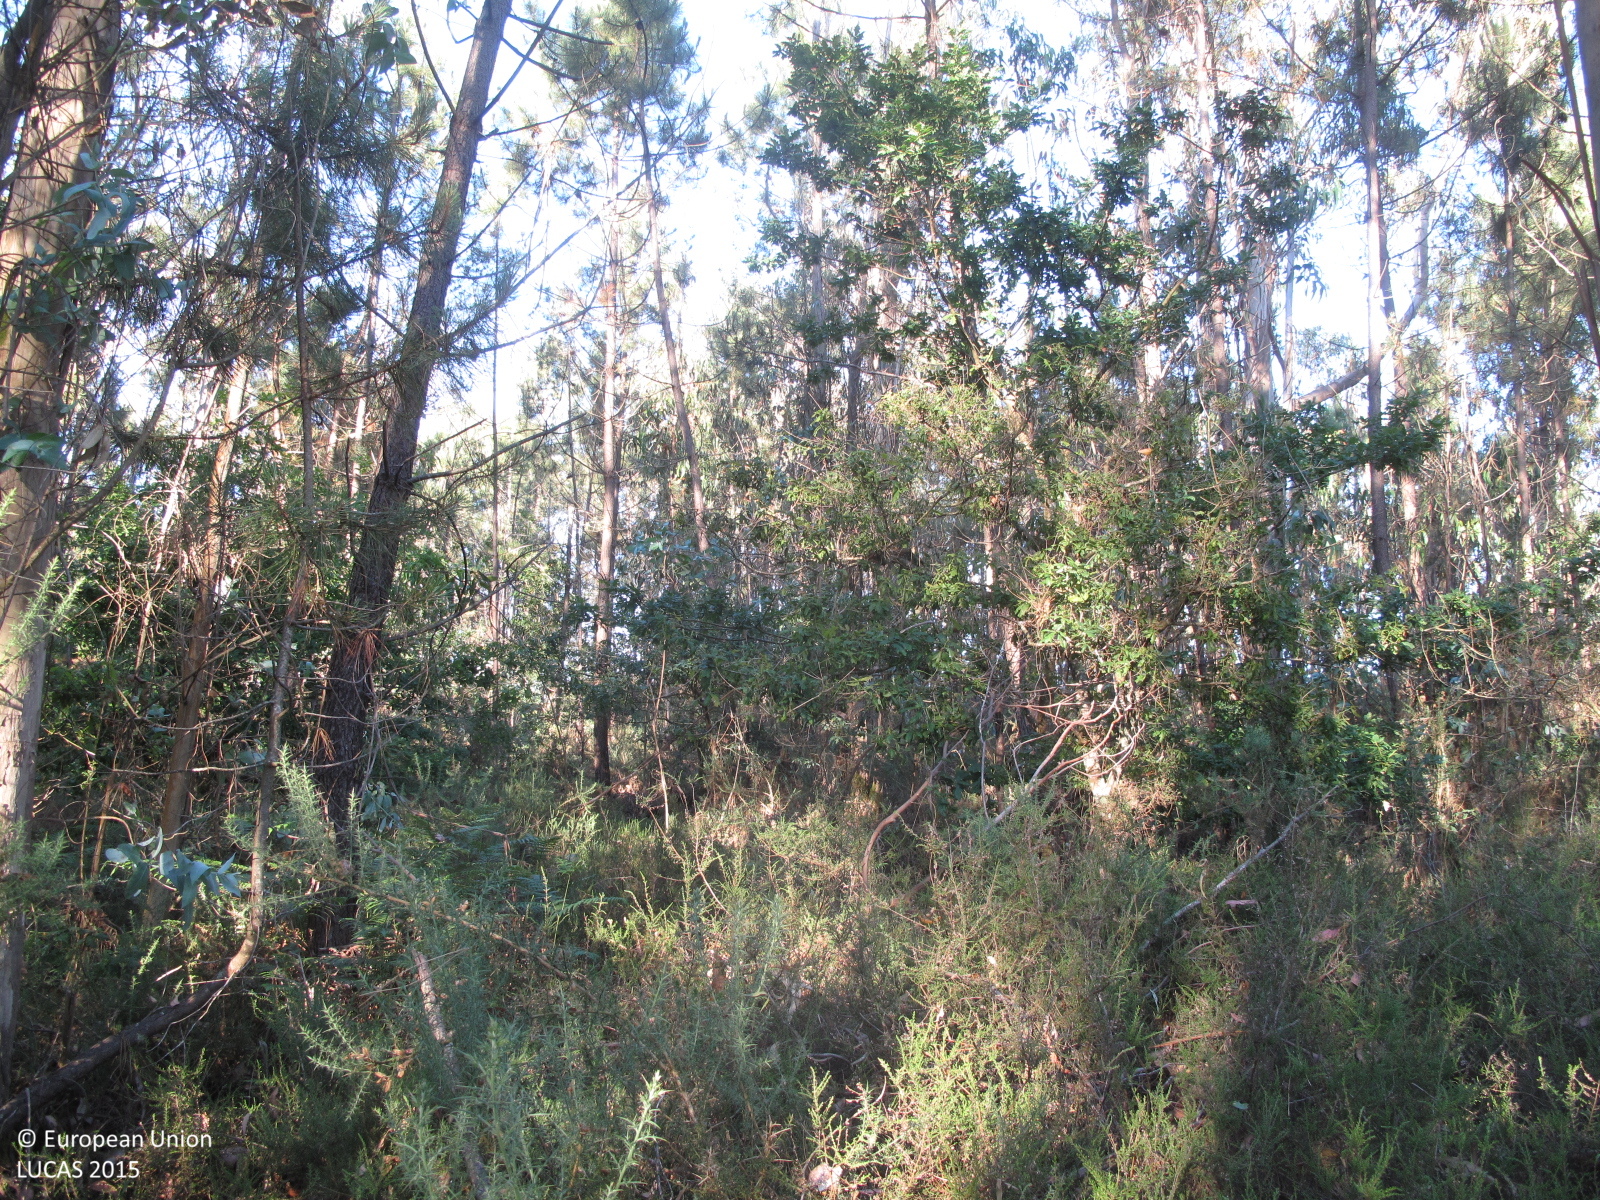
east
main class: Woodland
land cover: Other mixed woodland
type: exotic forest
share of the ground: 50 - 75 %
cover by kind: broadleaved forest trees 40 %, coniferous forest trees 30 %, shrubs 20 %, herbaceous plants 10 %
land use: Forestry
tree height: > 5 m
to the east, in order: Other mixed woodland; Shrubland with sparse tree cover; Broadleaved woodland; Other mixed woodland; Tracks; Other mixed woodland; Shrubland with sparse tree cover; Electric lines; Shrubland with sparse tree cover; Other mixed woodland
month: June
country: ES
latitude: 42.9720
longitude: -8.5596
